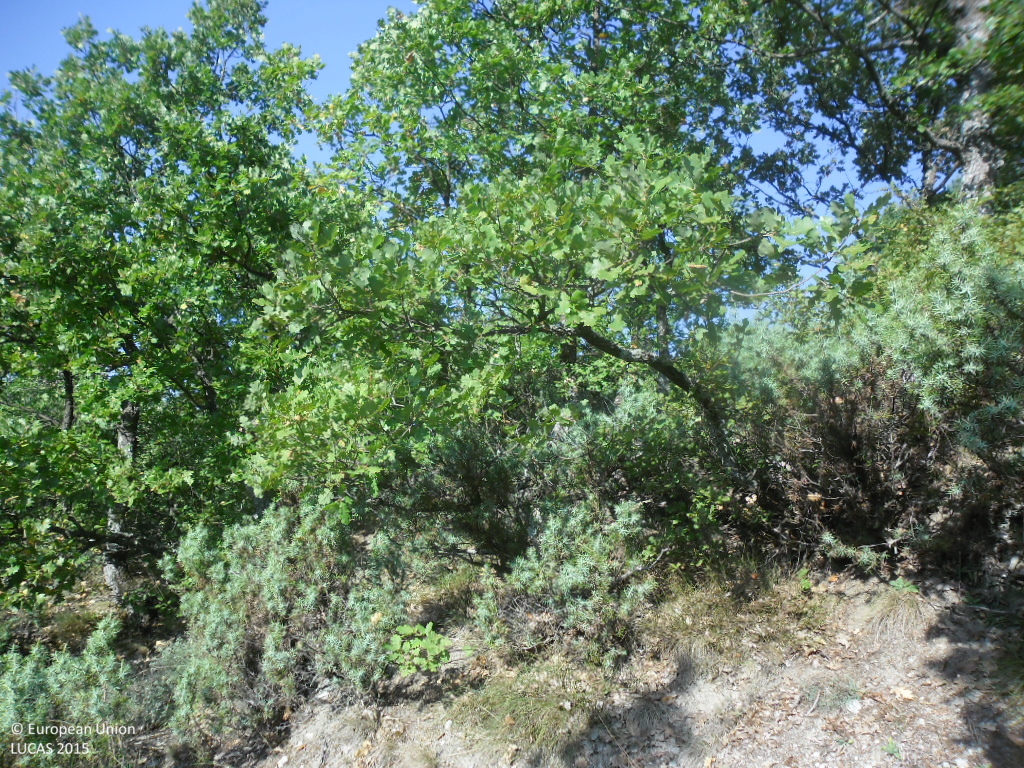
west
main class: Woodland
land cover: Broadleaved woodland
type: thermophilous deciduous forest
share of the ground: > 75 %
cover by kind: broadleaved forest trees 95 %, unconsolidated bare surface 5 %
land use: Forestry
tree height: > 5 m
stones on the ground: < 10 %
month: September
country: BG
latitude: 41.8665
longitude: 23.1432
